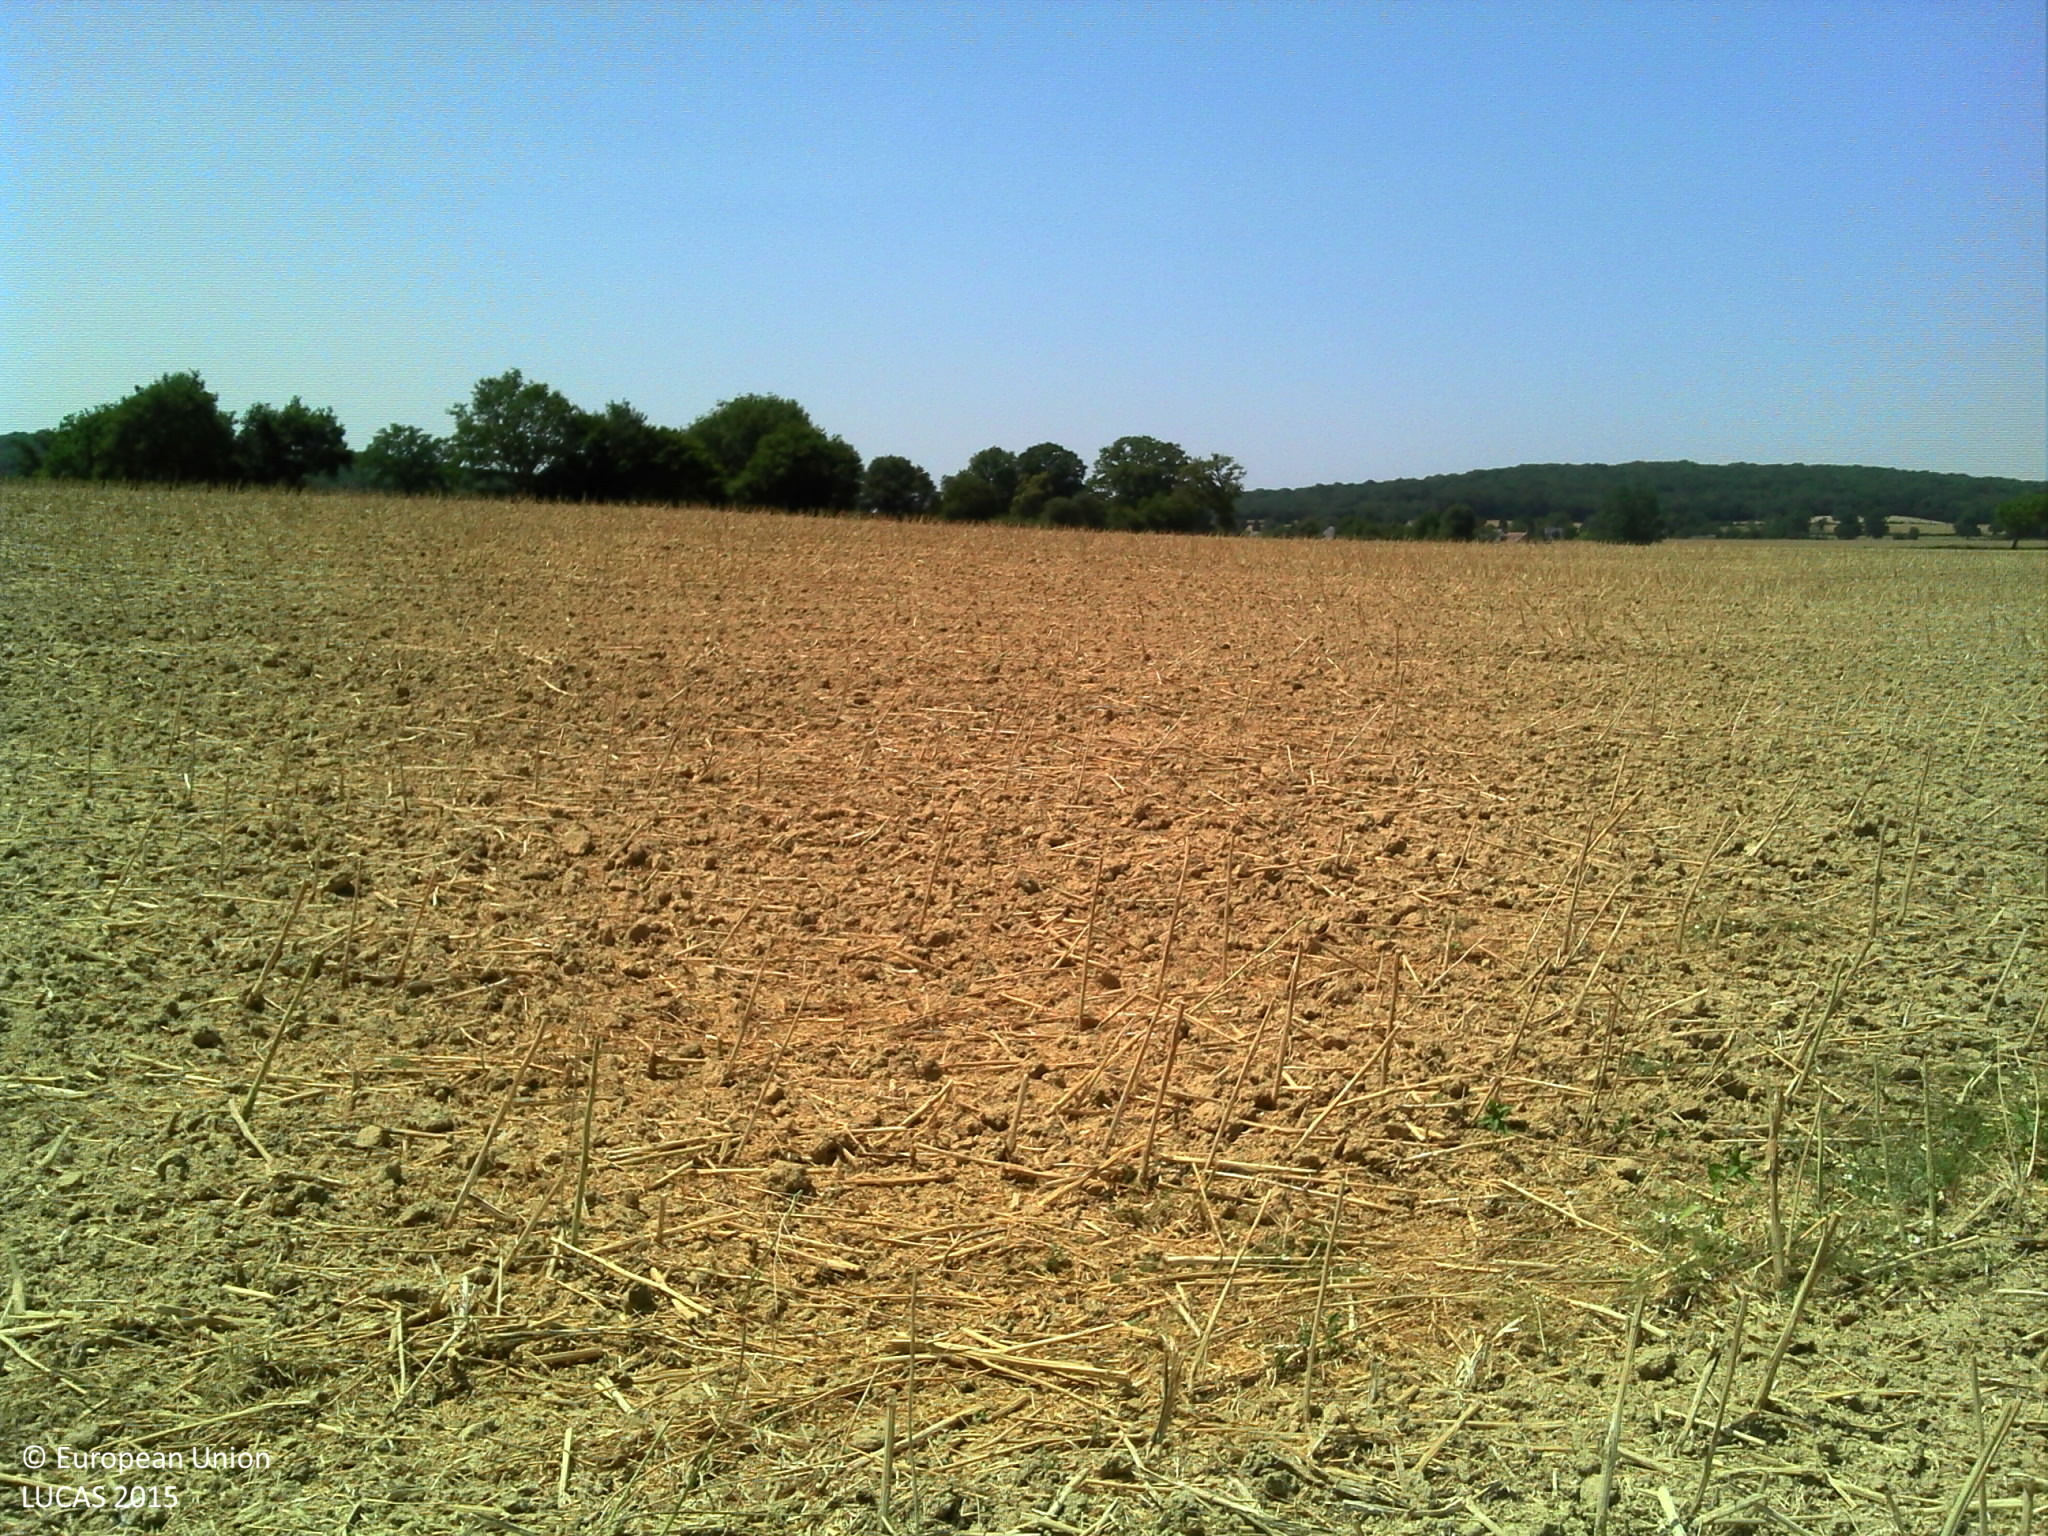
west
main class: Cropland
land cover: Rape and turnip rape
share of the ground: > 75 %
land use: Agriculture (excluding fallow land and kitchen gardens)
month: July
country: FR
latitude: 47.0095
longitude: 3.6184
